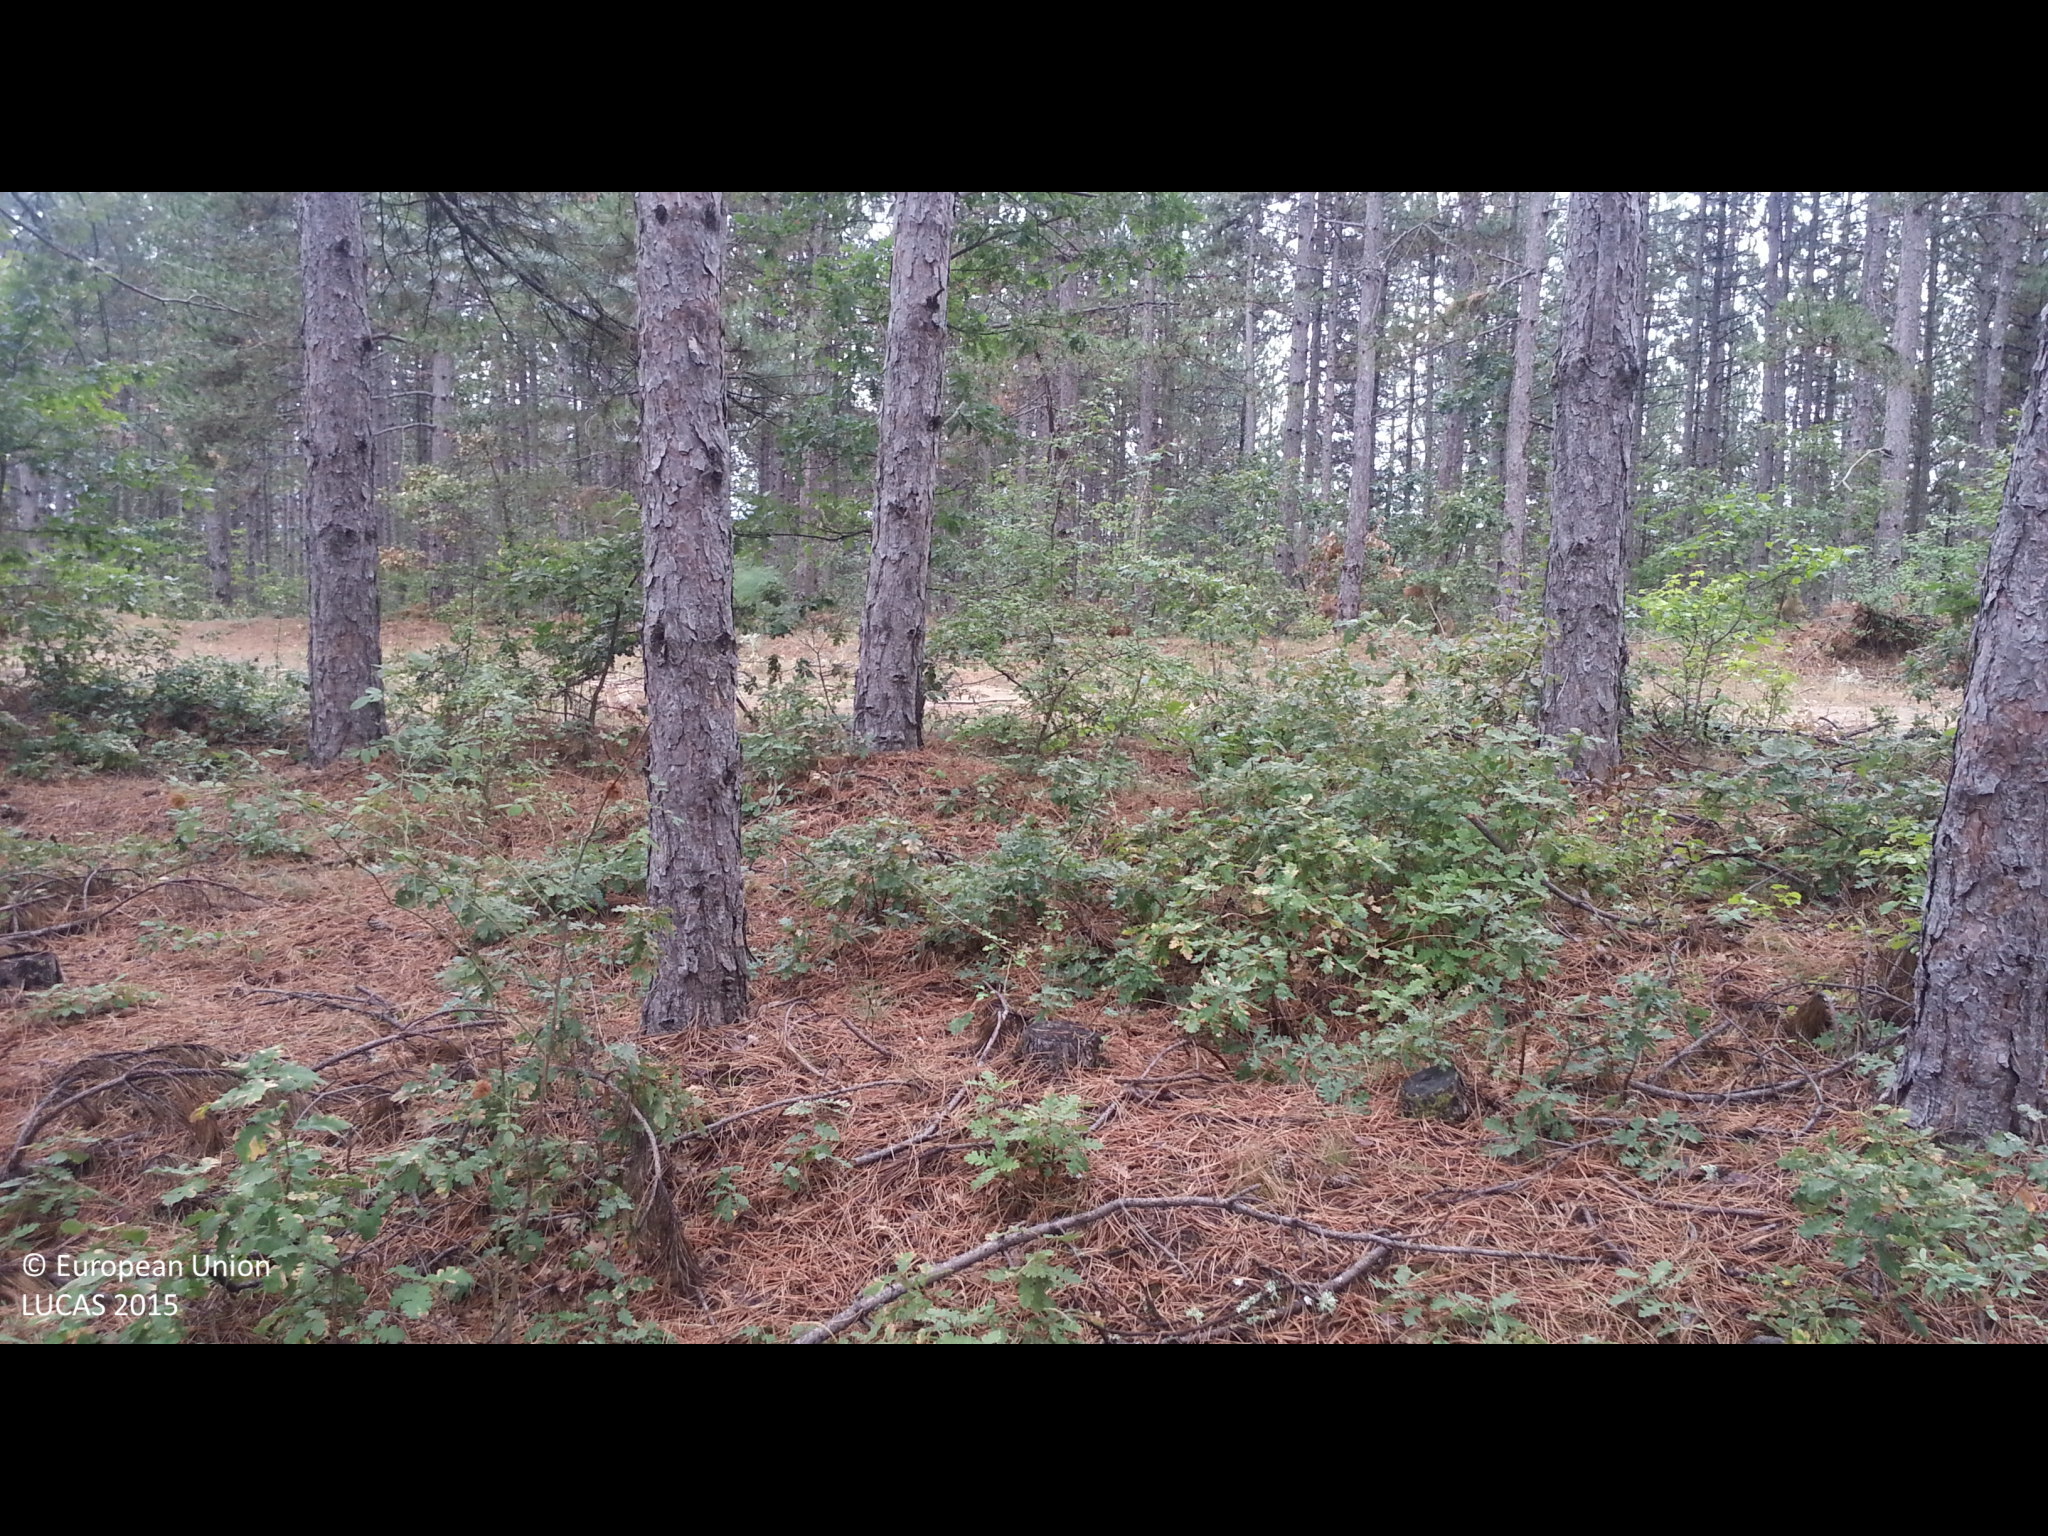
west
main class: Woodland
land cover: Pine dominated coniferous woodland
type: hemiboreal forest and nemoral coniferous forest and mixed broadleaved-coniferous forest
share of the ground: > 75 %
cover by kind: coniferous forest trees 95 %, shrubs 5 %
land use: Forestry
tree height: > 5 m
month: August
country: BG
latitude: 42.2862
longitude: 22.8668
